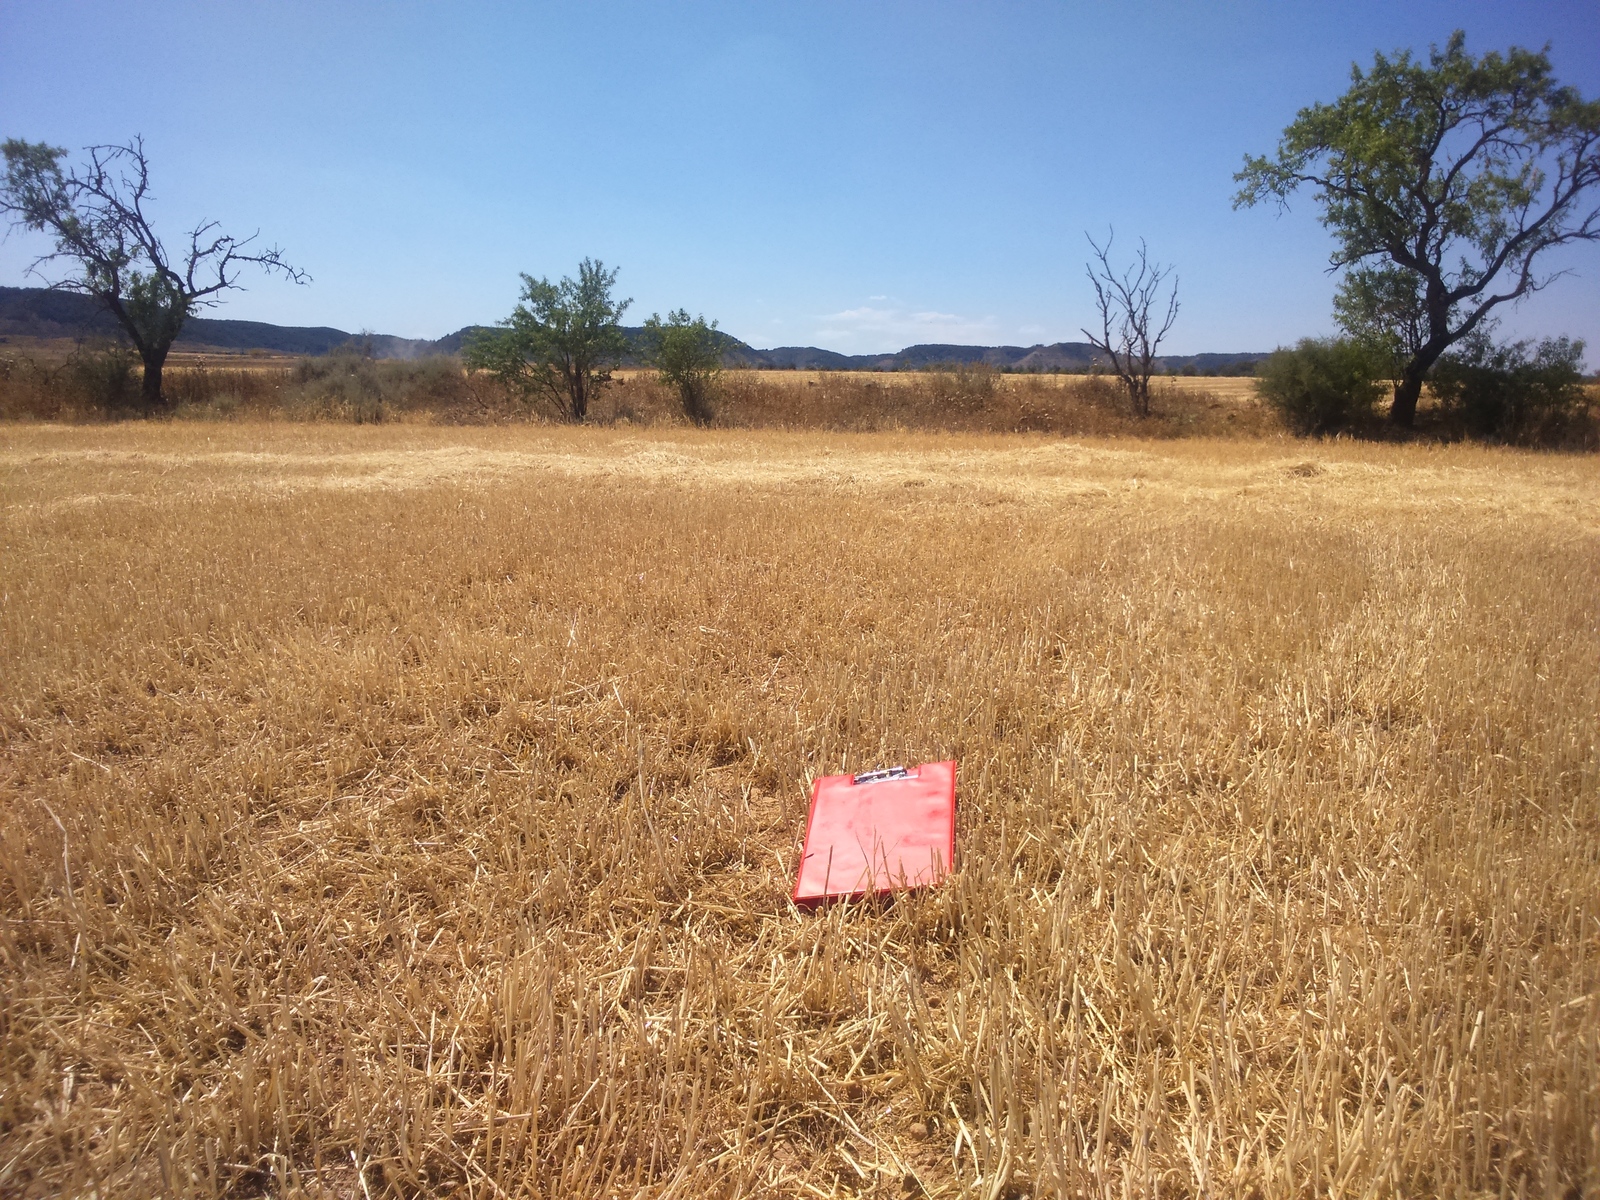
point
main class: Cropland
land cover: Barley
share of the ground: < 10 %
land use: Agriculture (excluding fallow land and kitchen gardens)
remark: Harvested field
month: June
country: ES
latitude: 41.6004
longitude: 0.0626
